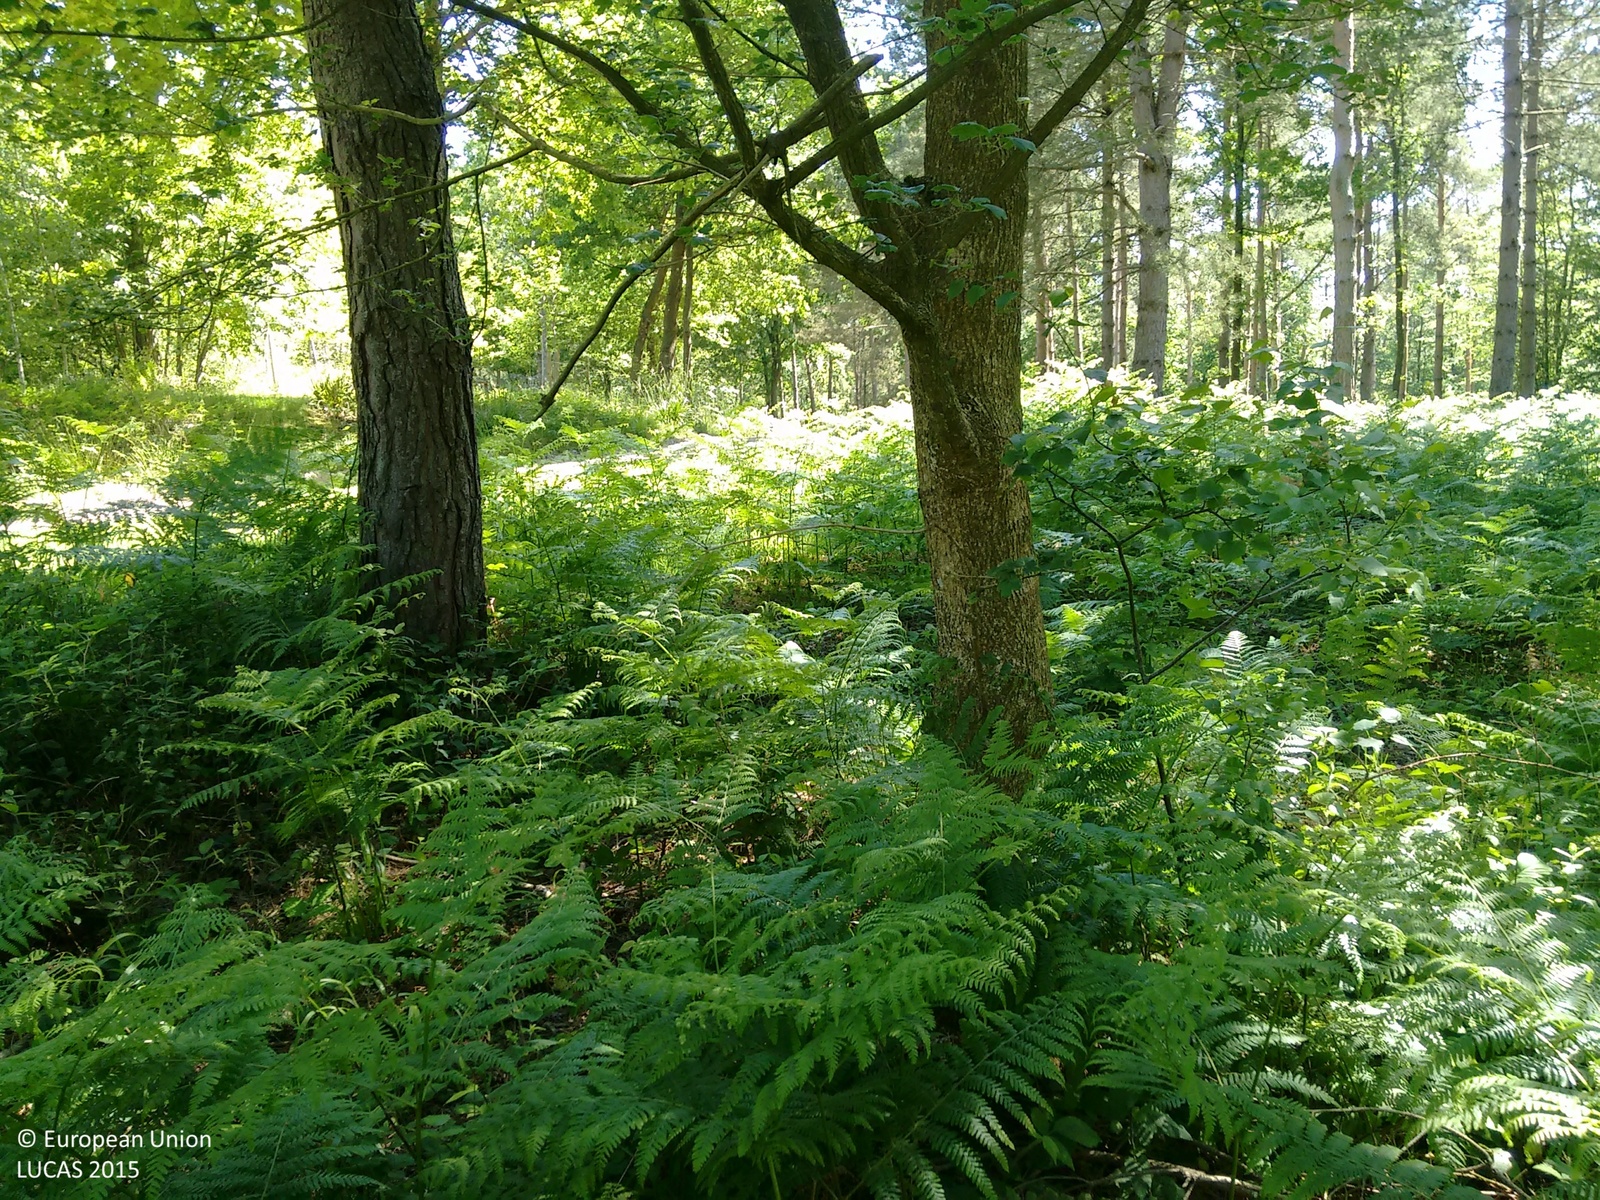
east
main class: Woodland
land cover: Pine dominated coniferous woodland
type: exotic forest
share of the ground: > 75 %
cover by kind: coniferous forest trees 85 %, shrubs 10 %, herbaceous plants 5 %
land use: Forestry
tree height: > 5 m
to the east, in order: Pine dominated coniferous woodland; Tracks; Broadleaved woodland
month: June
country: GB
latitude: 50.9771
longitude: 0.4433
